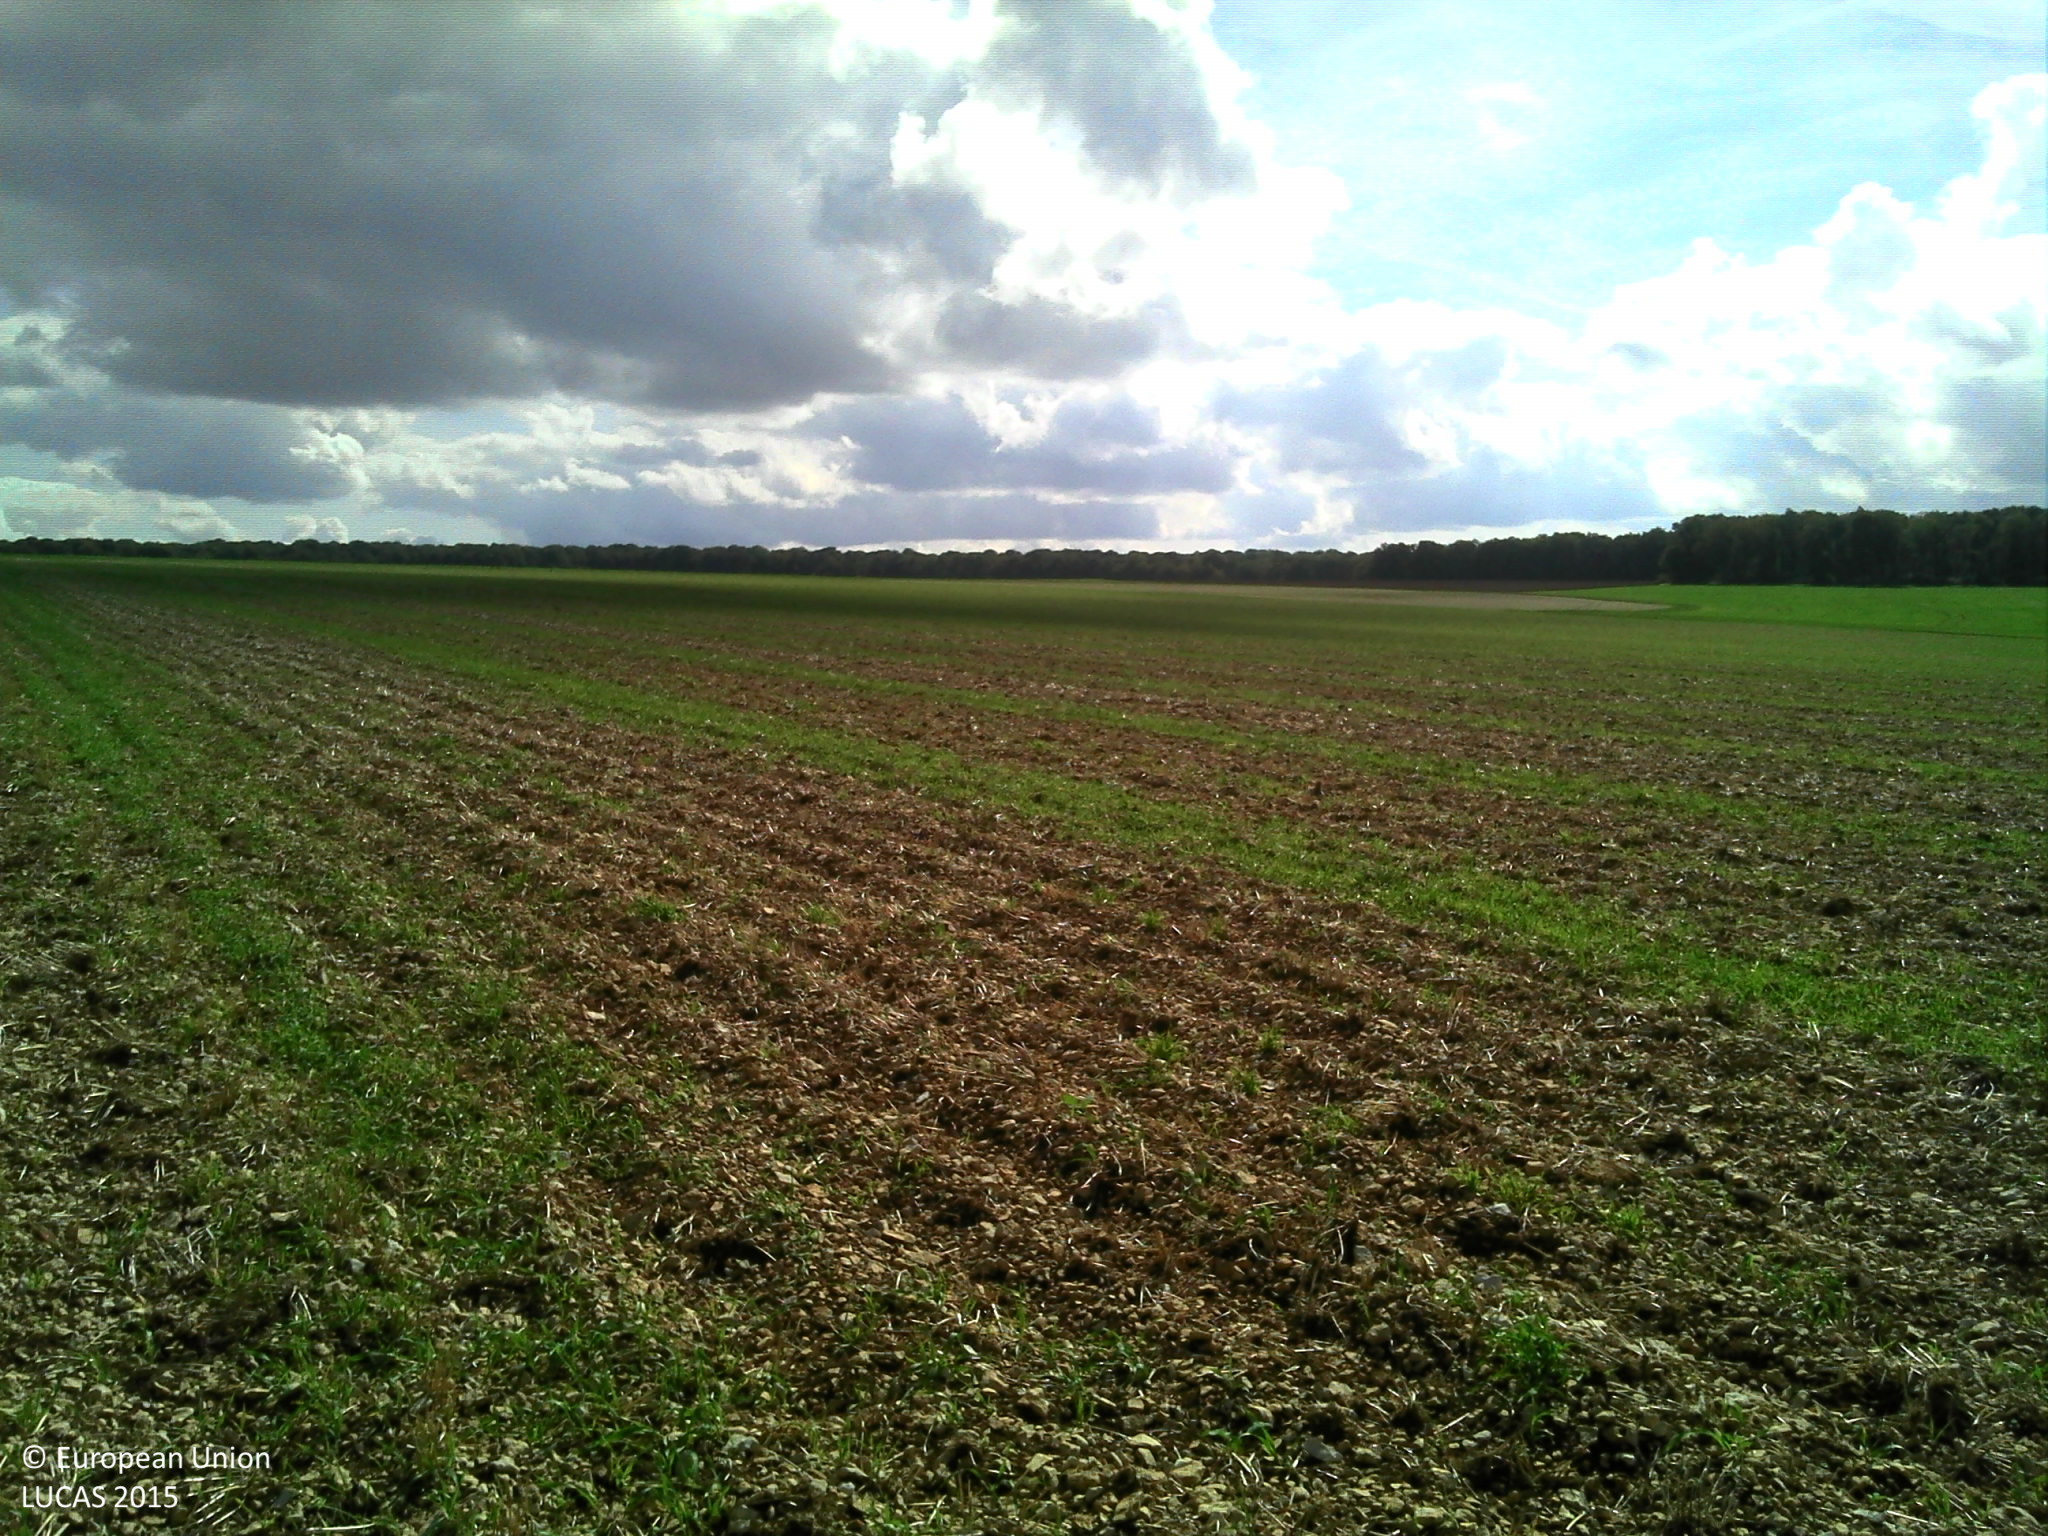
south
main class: Cropland
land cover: Barley
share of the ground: > 75 %
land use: Agriculture (excluding fallow land and kitchen gardens)
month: September
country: FR
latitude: 48.0371
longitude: 4.2435
